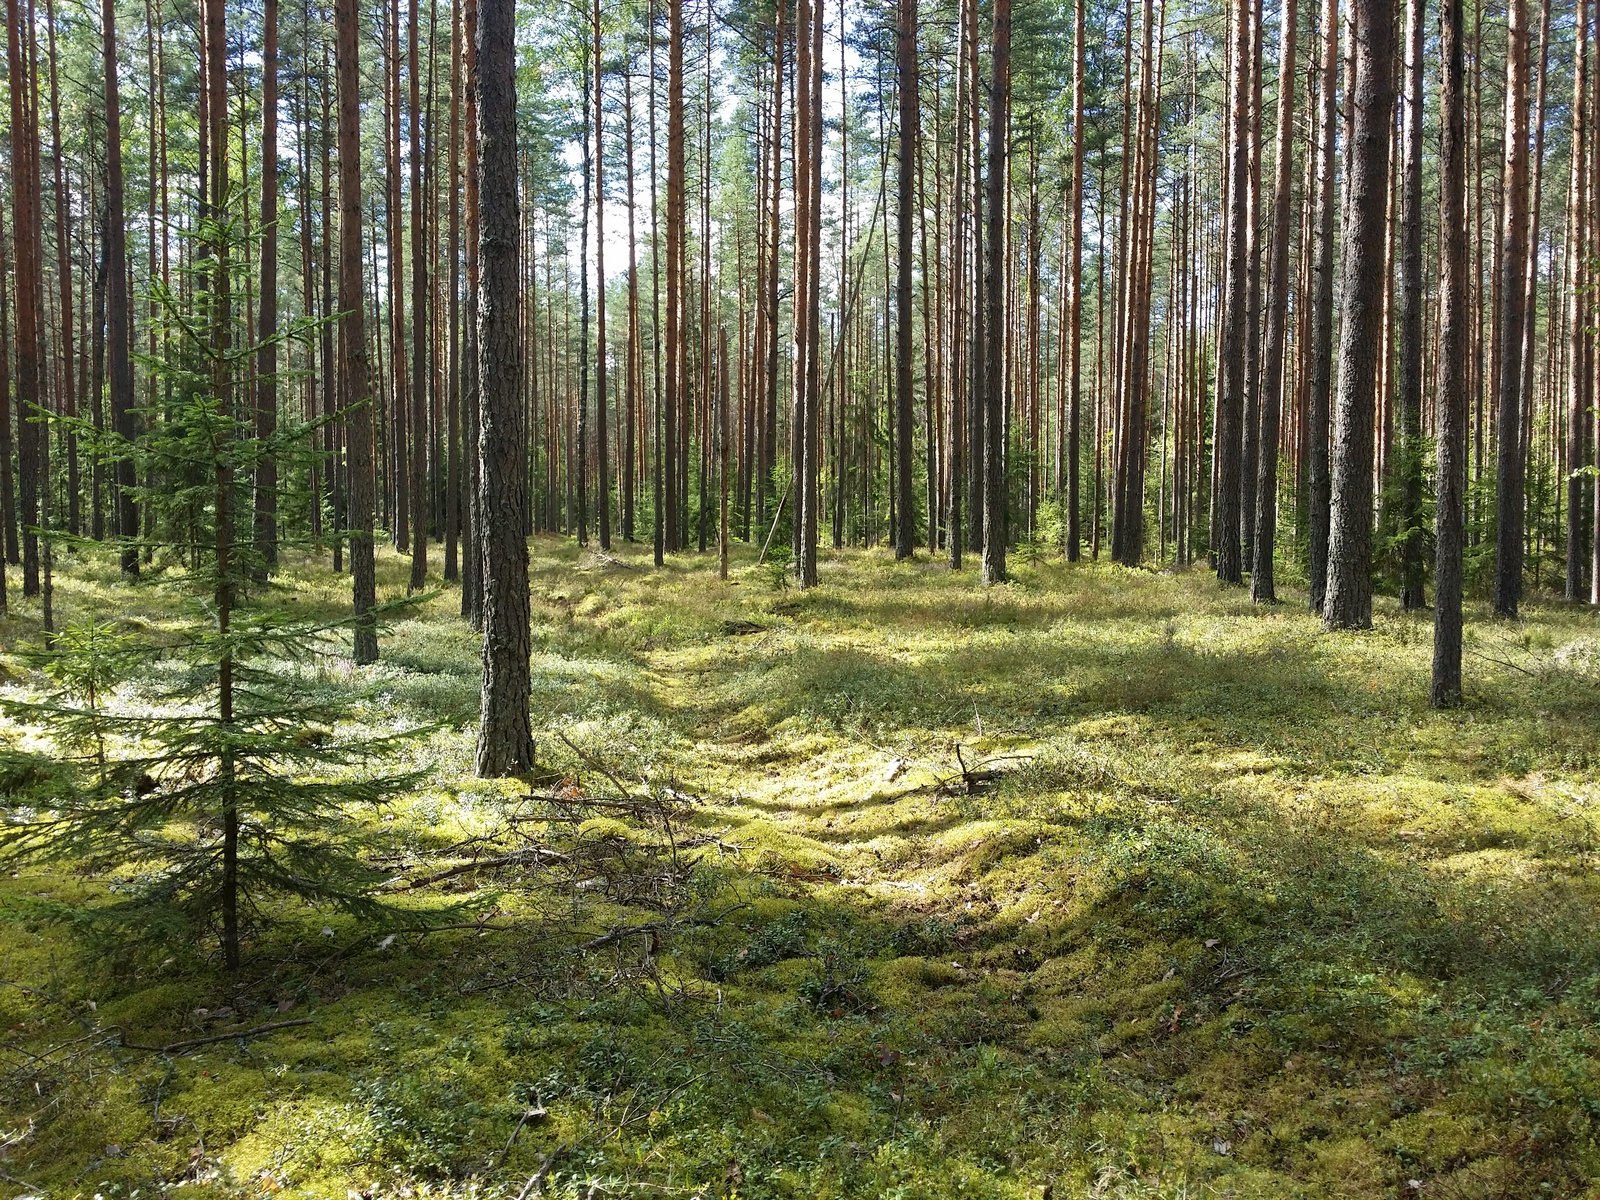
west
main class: Woodland
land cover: Pine dominated coniferous woodland
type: hemiboreal forest and nemoral coniferous forest and mixed broadleaved-coniferous forest
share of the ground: 50 - 75 %
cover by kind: coniferous forest trees 70 %, lichens and mosses 25 %, shrubs 5 %
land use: Forestry
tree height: > 5 m
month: August
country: LV
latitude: 57.3119
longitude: 27.6622
